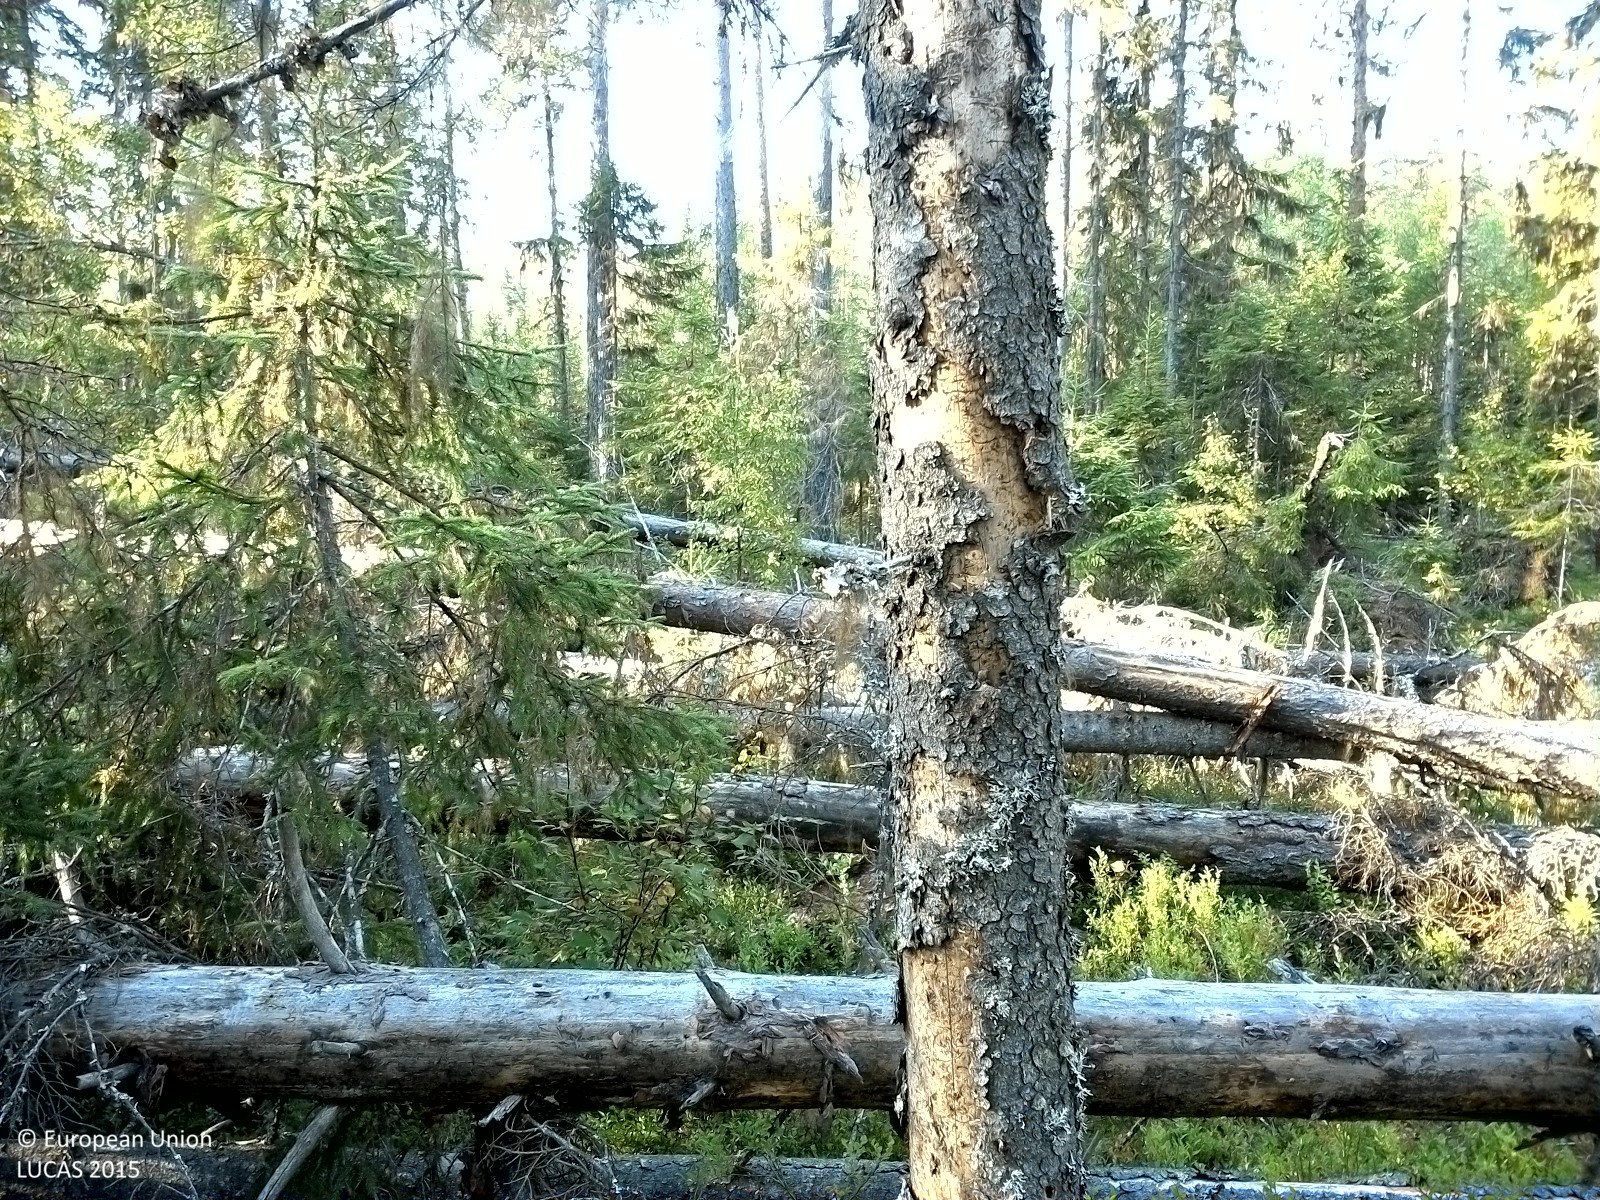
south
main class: Woodland
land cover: Pine dominated coniferous woodland
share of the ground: 25 - 50 %
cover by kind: coniferous forest trees 50 %, lichens and mosses 30 %, shrubs 20 %
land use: Forestry
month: September
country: SE
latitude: 62.5983
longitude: 16.0750
